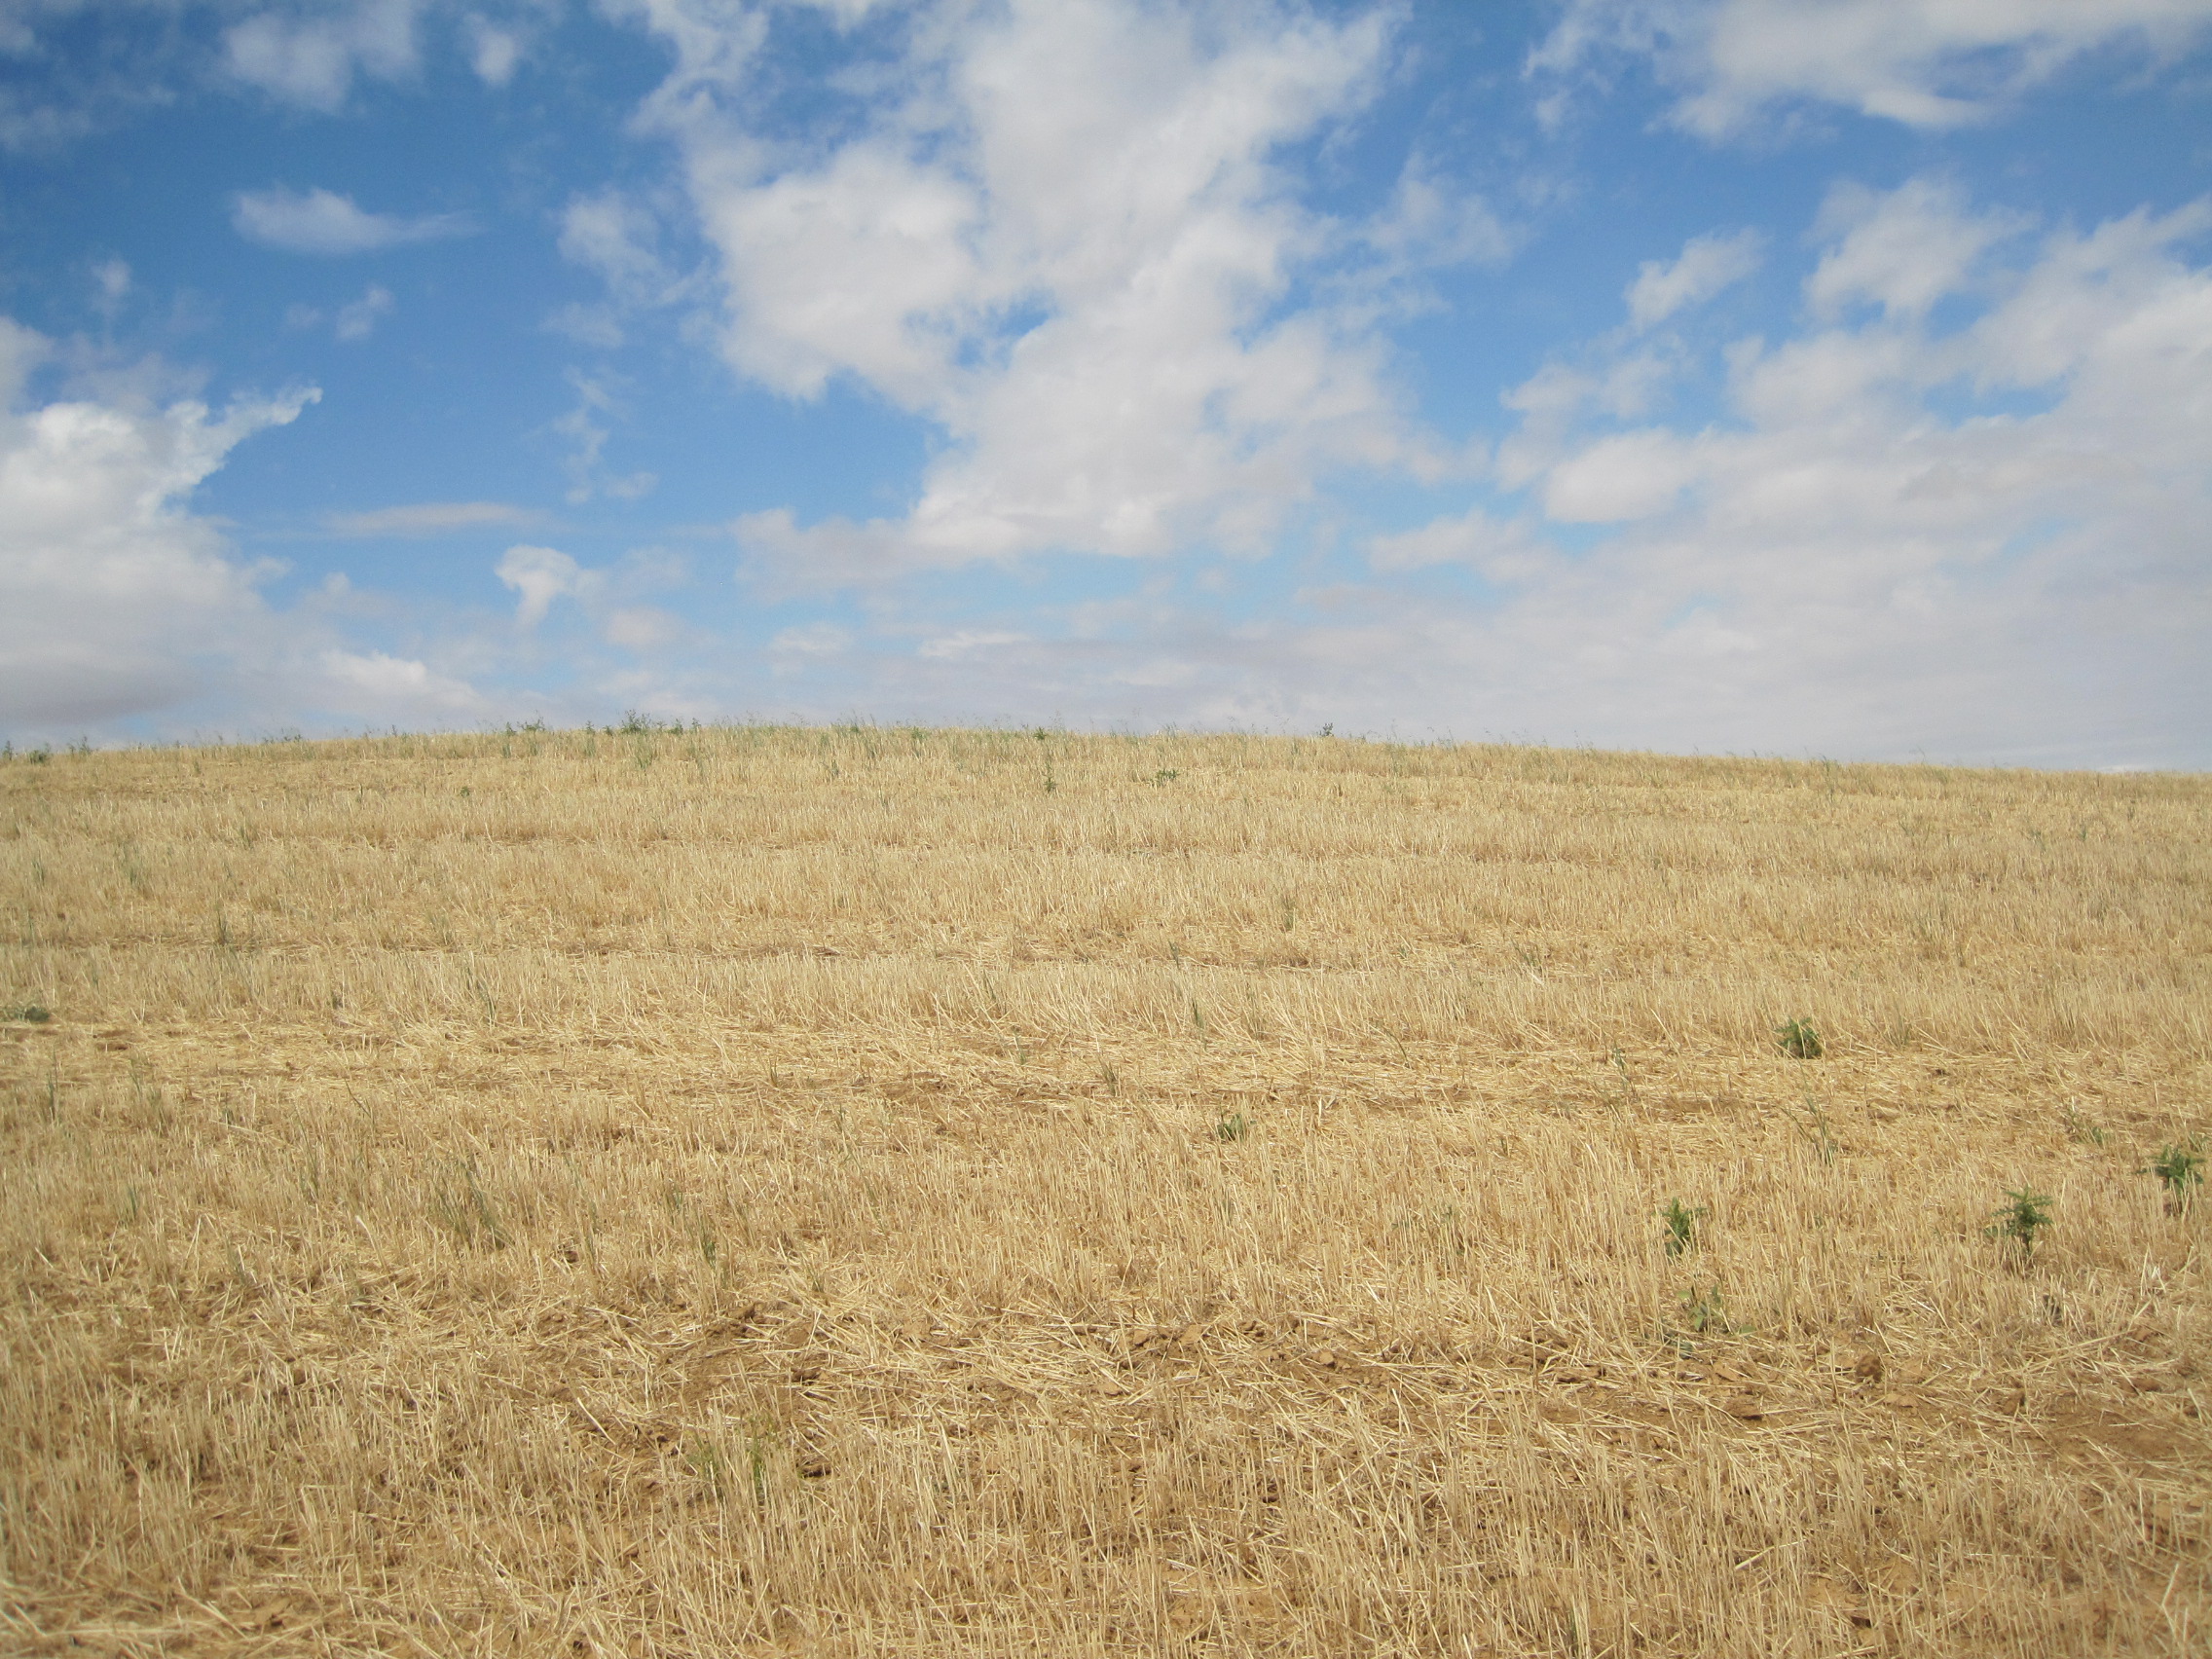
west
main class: Cropland
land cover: Barley
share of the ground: < 10 %
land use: Agriculture (excluding fallow land and kitchen gardens)
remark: Harvested field
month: July
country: ES
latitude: 42.0638
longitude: -5.2259
